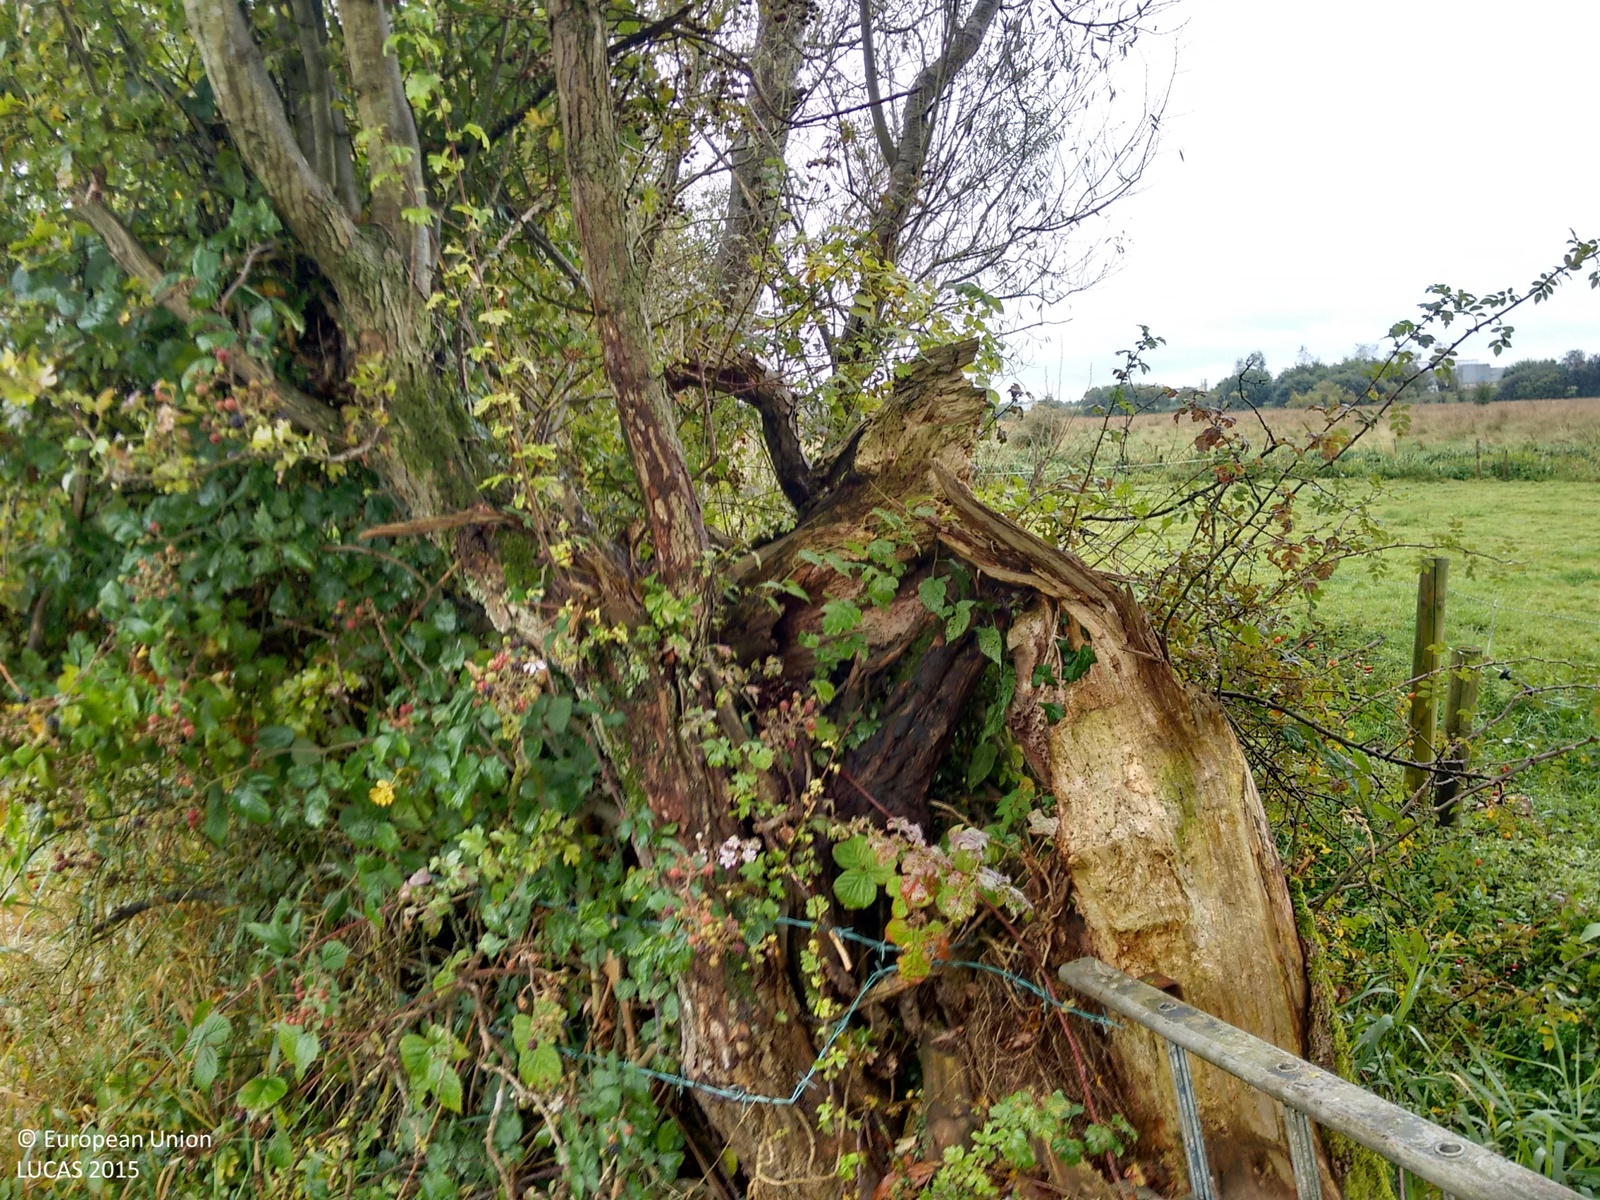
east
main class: Grassland
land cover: Grassland without tree/shrub cover
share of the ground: > 75 %
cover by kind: herbaceous plants 100 %
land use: Agriculture (excluding fallow land and kitchen gardens)
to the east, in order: Grassland without tree/shrub cover; Fences; Ditches and canals; Grassland without tree/shrub cover
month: October
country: IE
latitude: 53.6799
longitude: -7.9940
